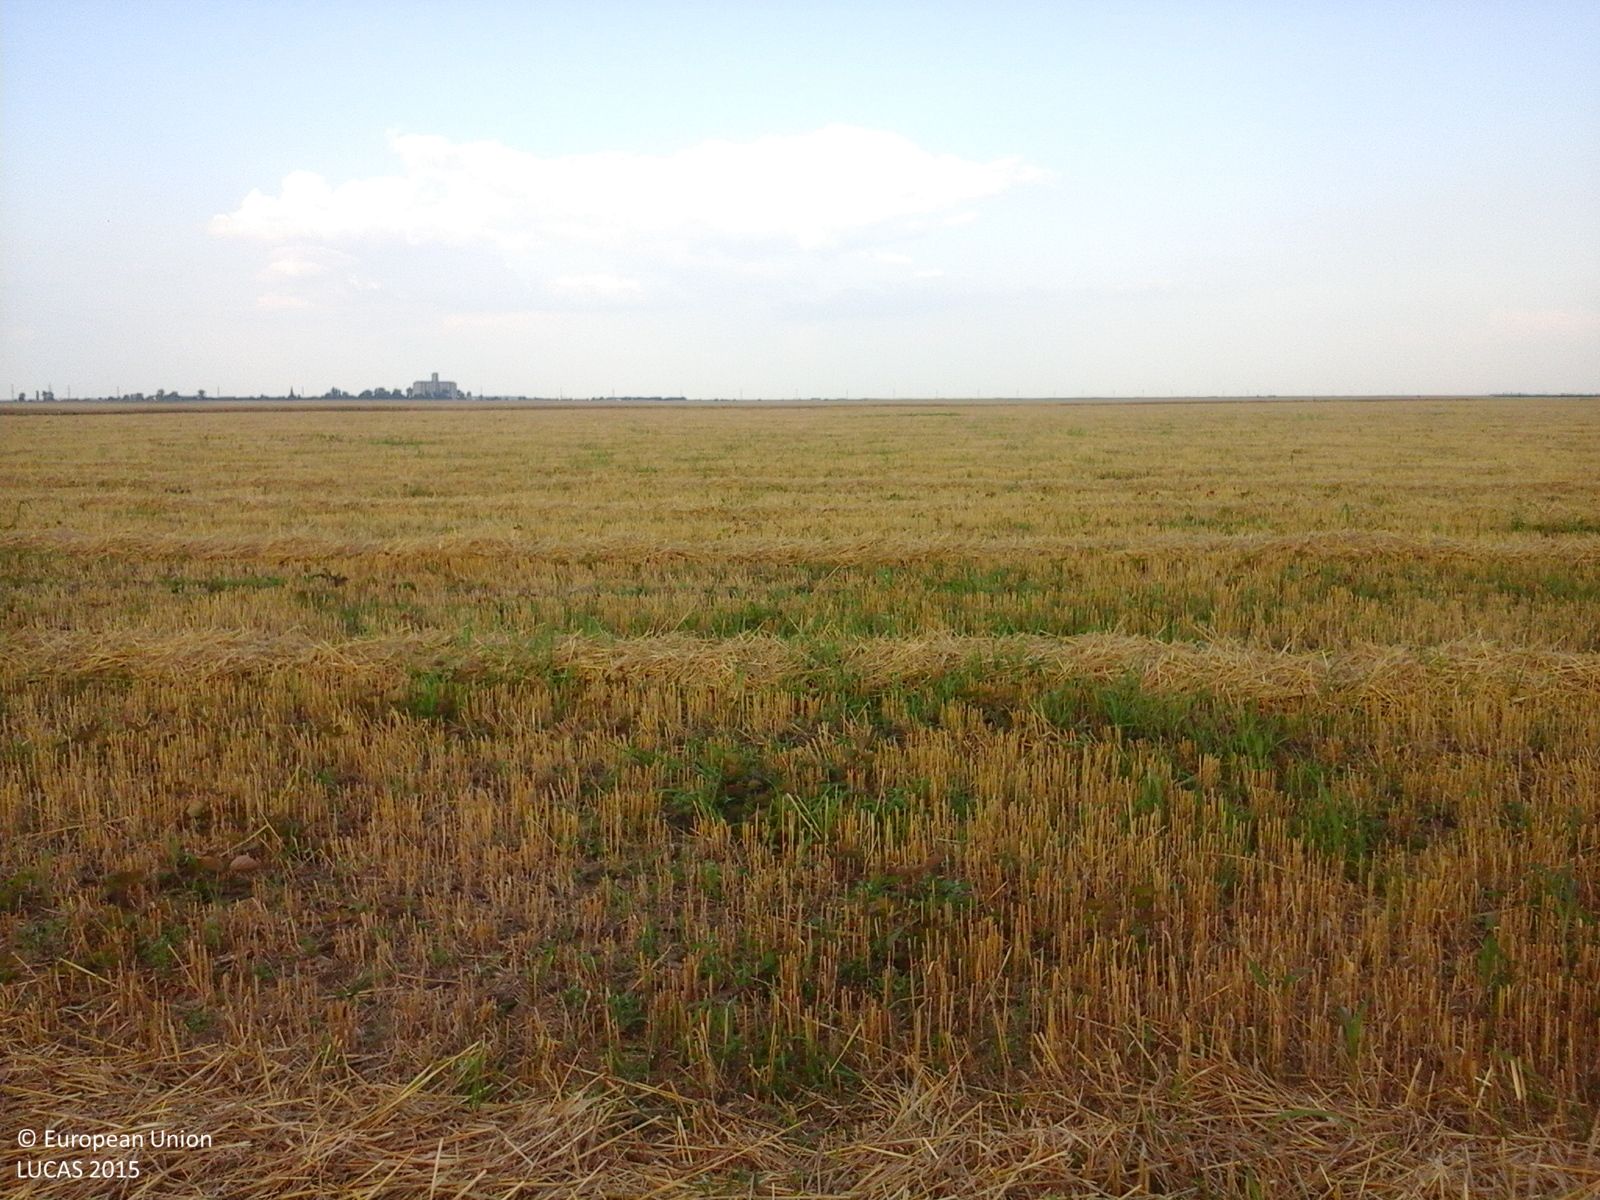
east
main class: Cropland
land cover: Rye
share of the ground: < 10 %
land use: Agriculture (excluding fallow land and kitchen gardens)
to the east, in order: Rye
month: July
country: RO
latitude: 43.9669
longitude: 25.7339
